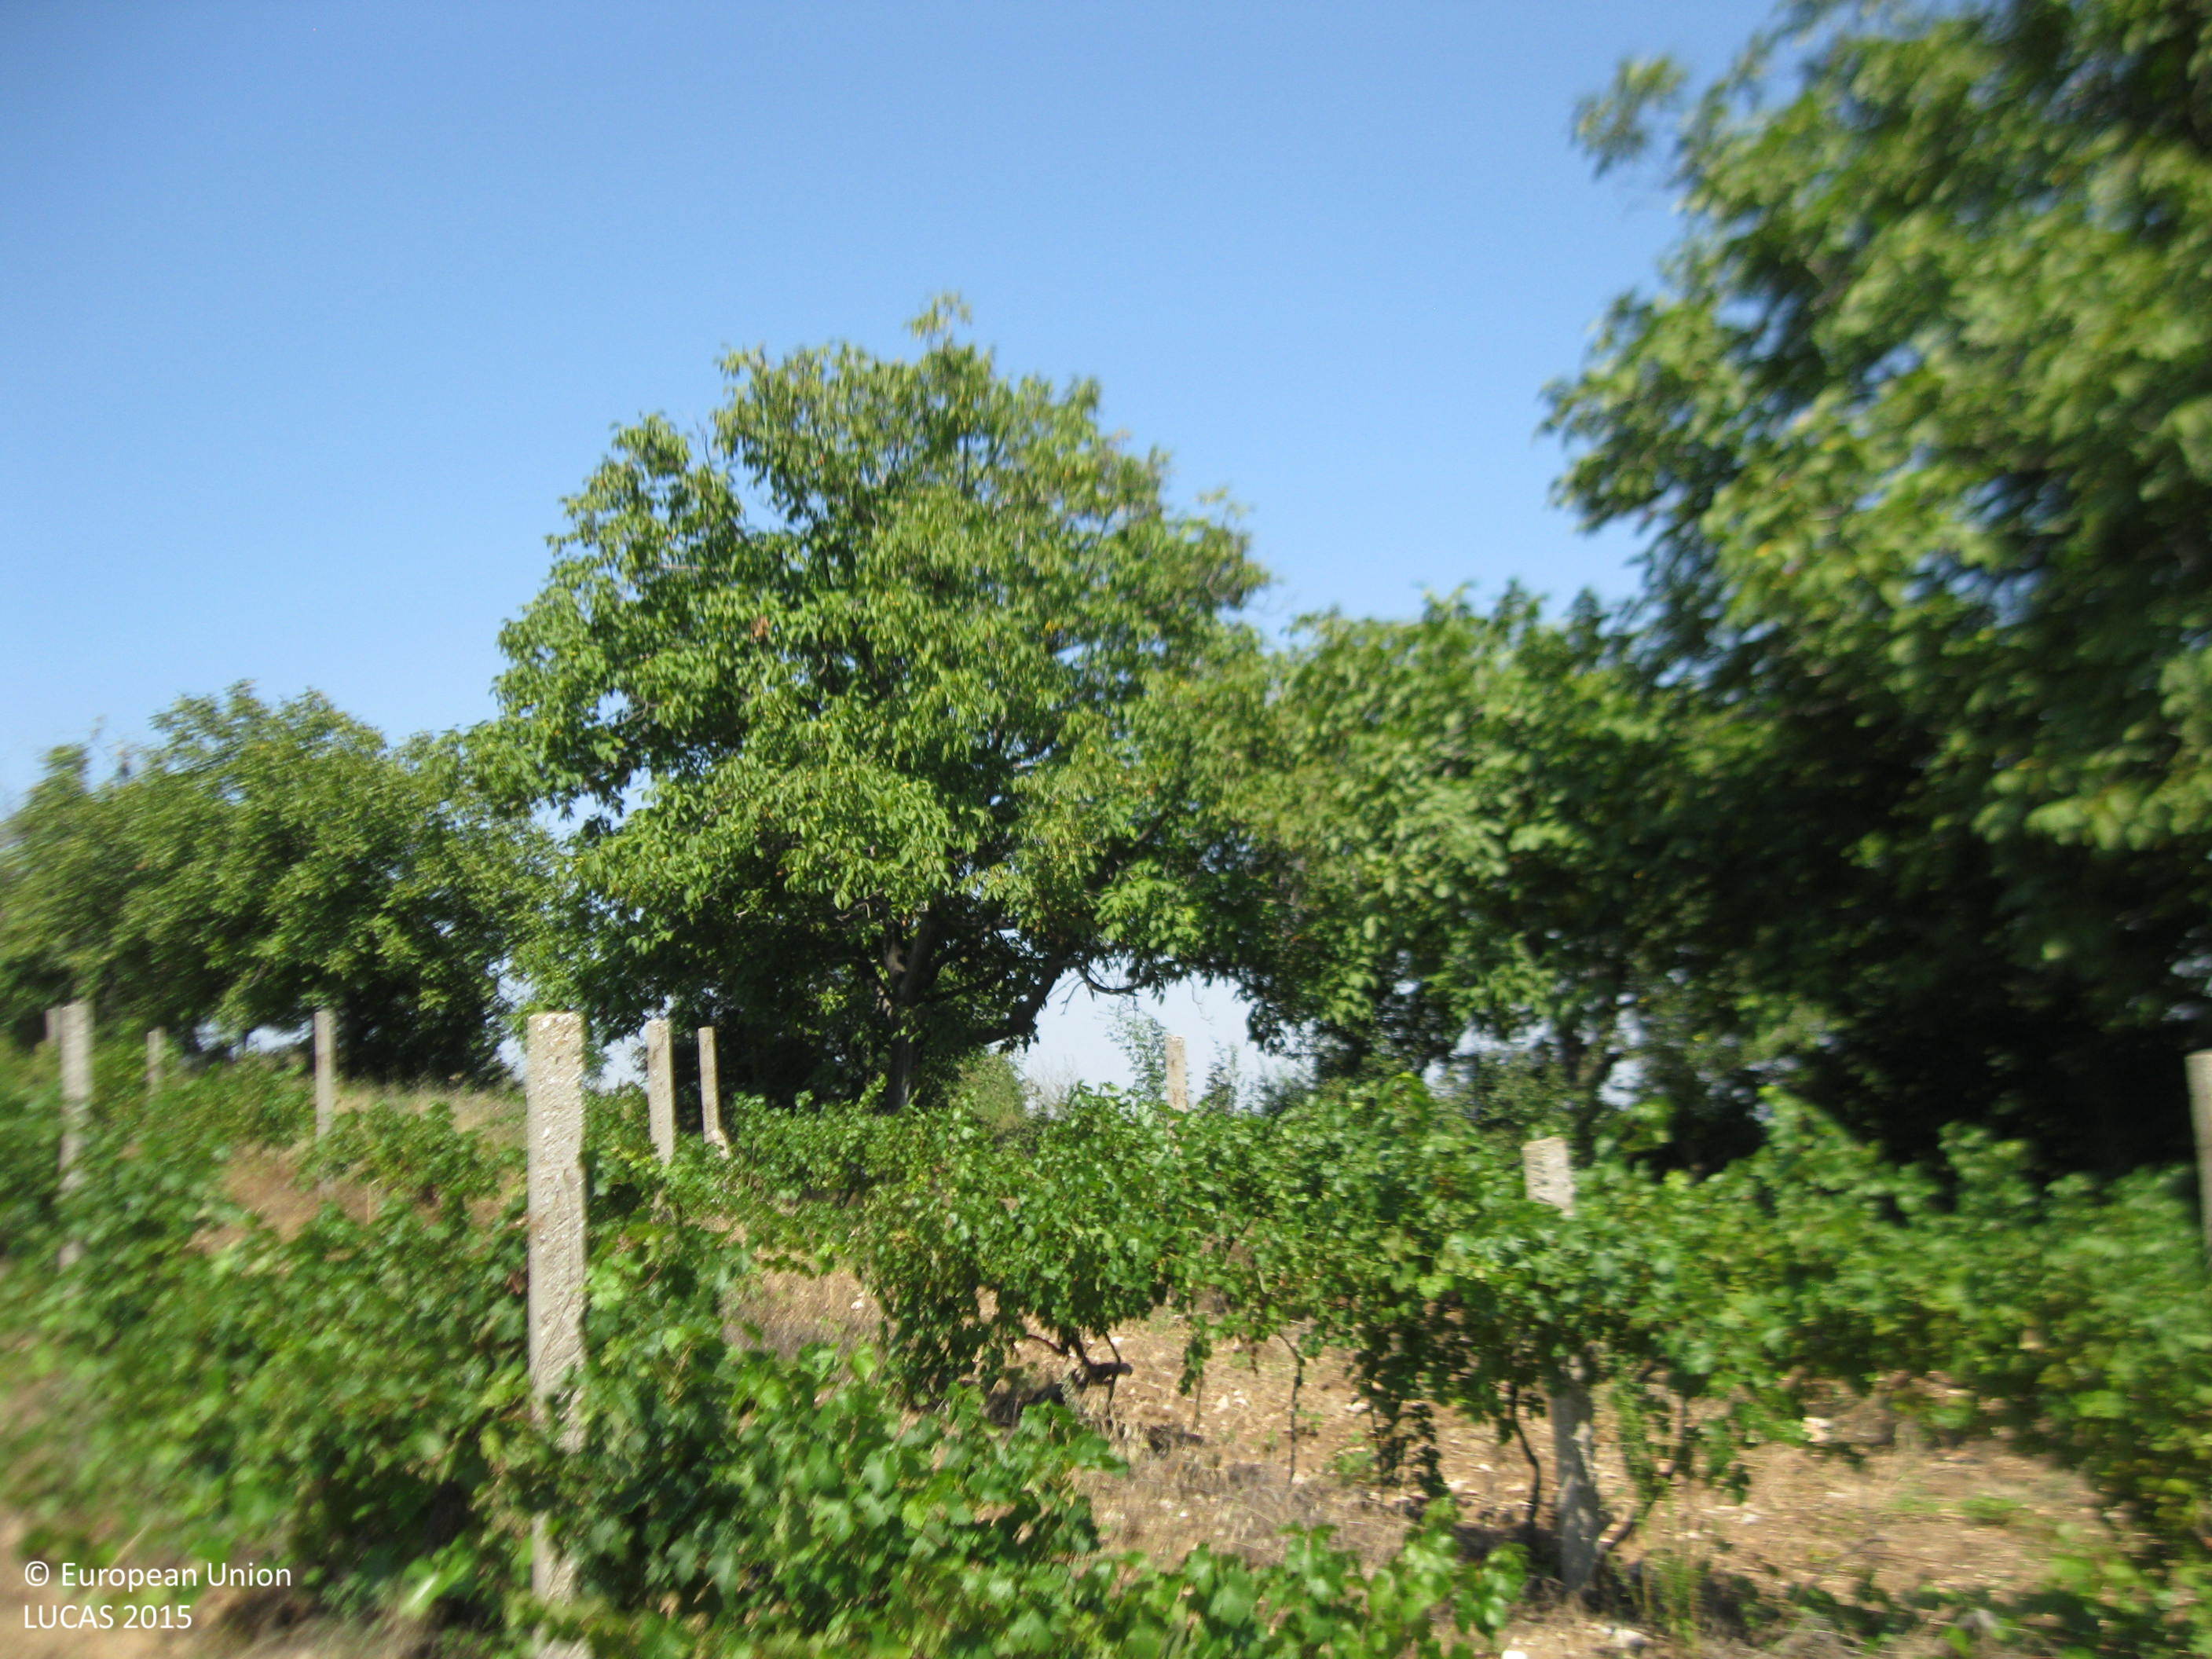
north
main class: Cropland
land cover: Vineyards
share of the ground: 25 - 50 %
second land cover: Spontaneously vegetated surfaces
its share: 50 - 75 %
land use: Agriculture (excluding fallow land and kitchen gardens)
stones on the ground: 10 - 25 %
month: August
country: BG
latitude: 41.9373
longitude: 24.9724
